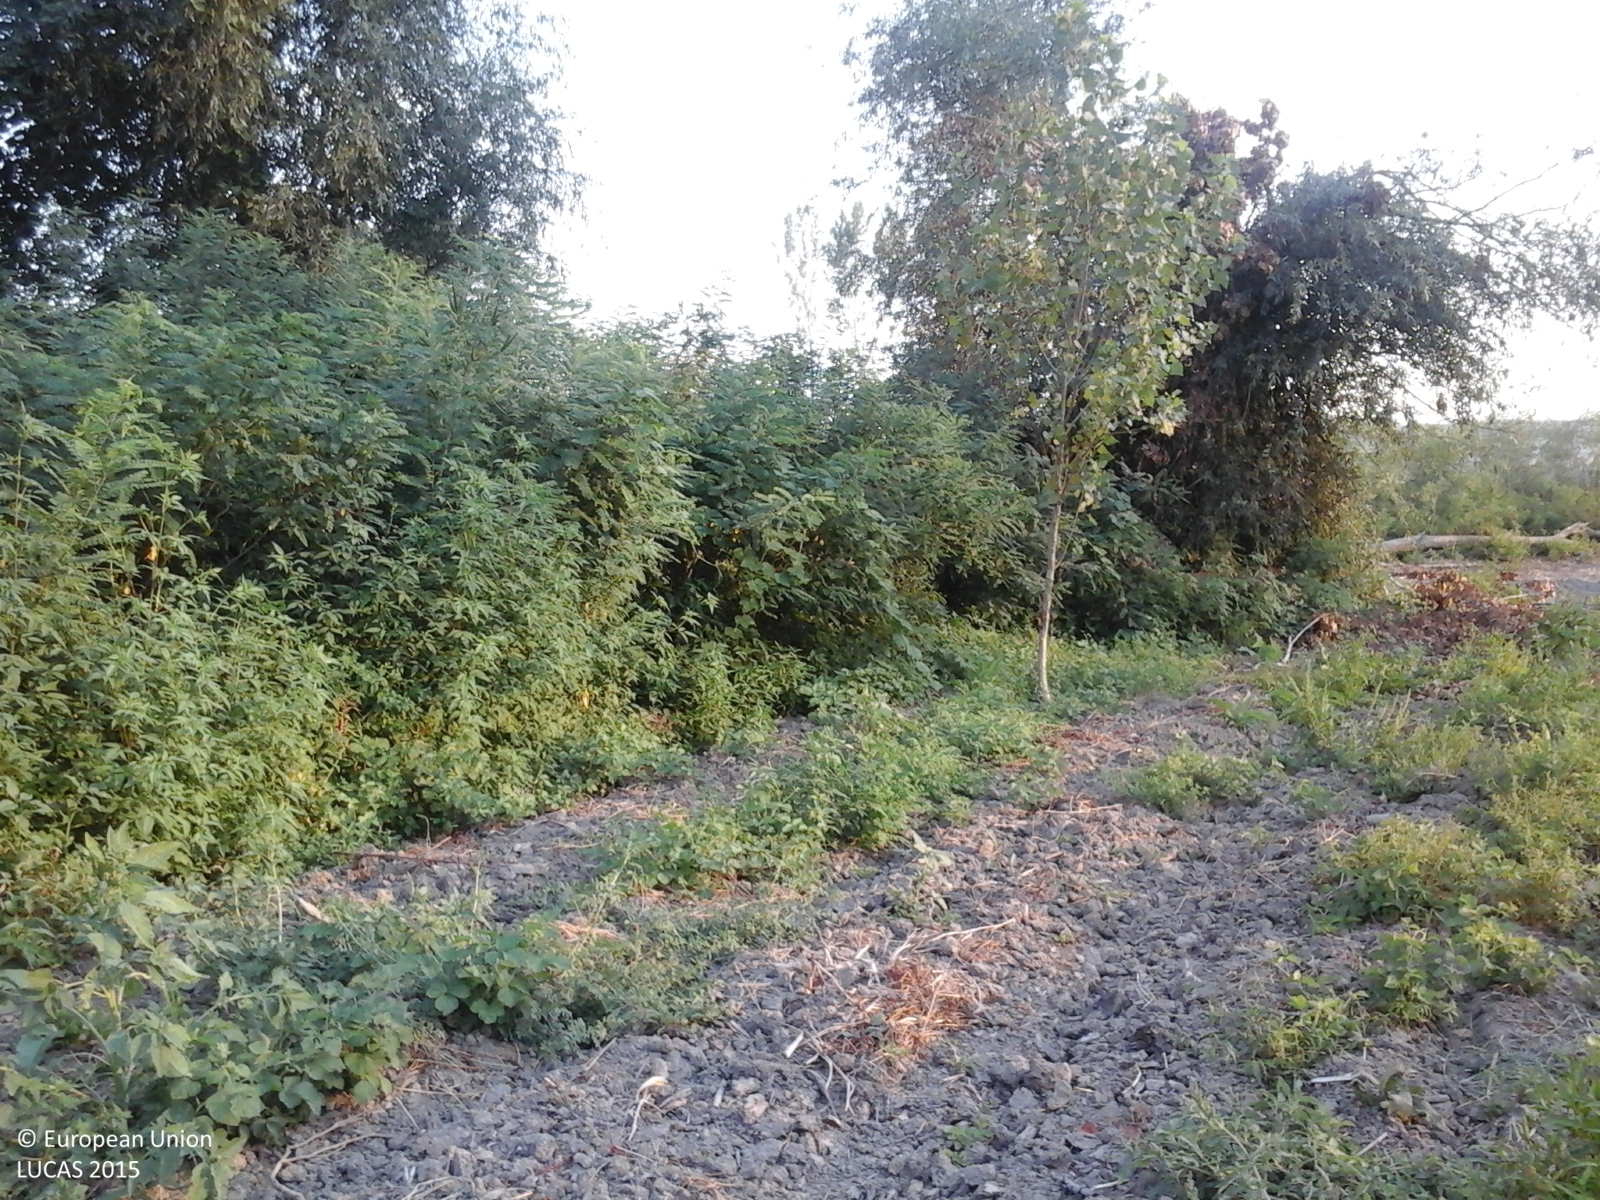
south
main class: Woodland
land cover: Broadleaved woodland
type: floodplain forest
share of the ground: > 75 %
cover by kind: broadleaved forest trees 100 %
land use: Forestry
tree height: > 5 m
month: August
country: RO
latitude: 43.8546
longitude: 23.4454
